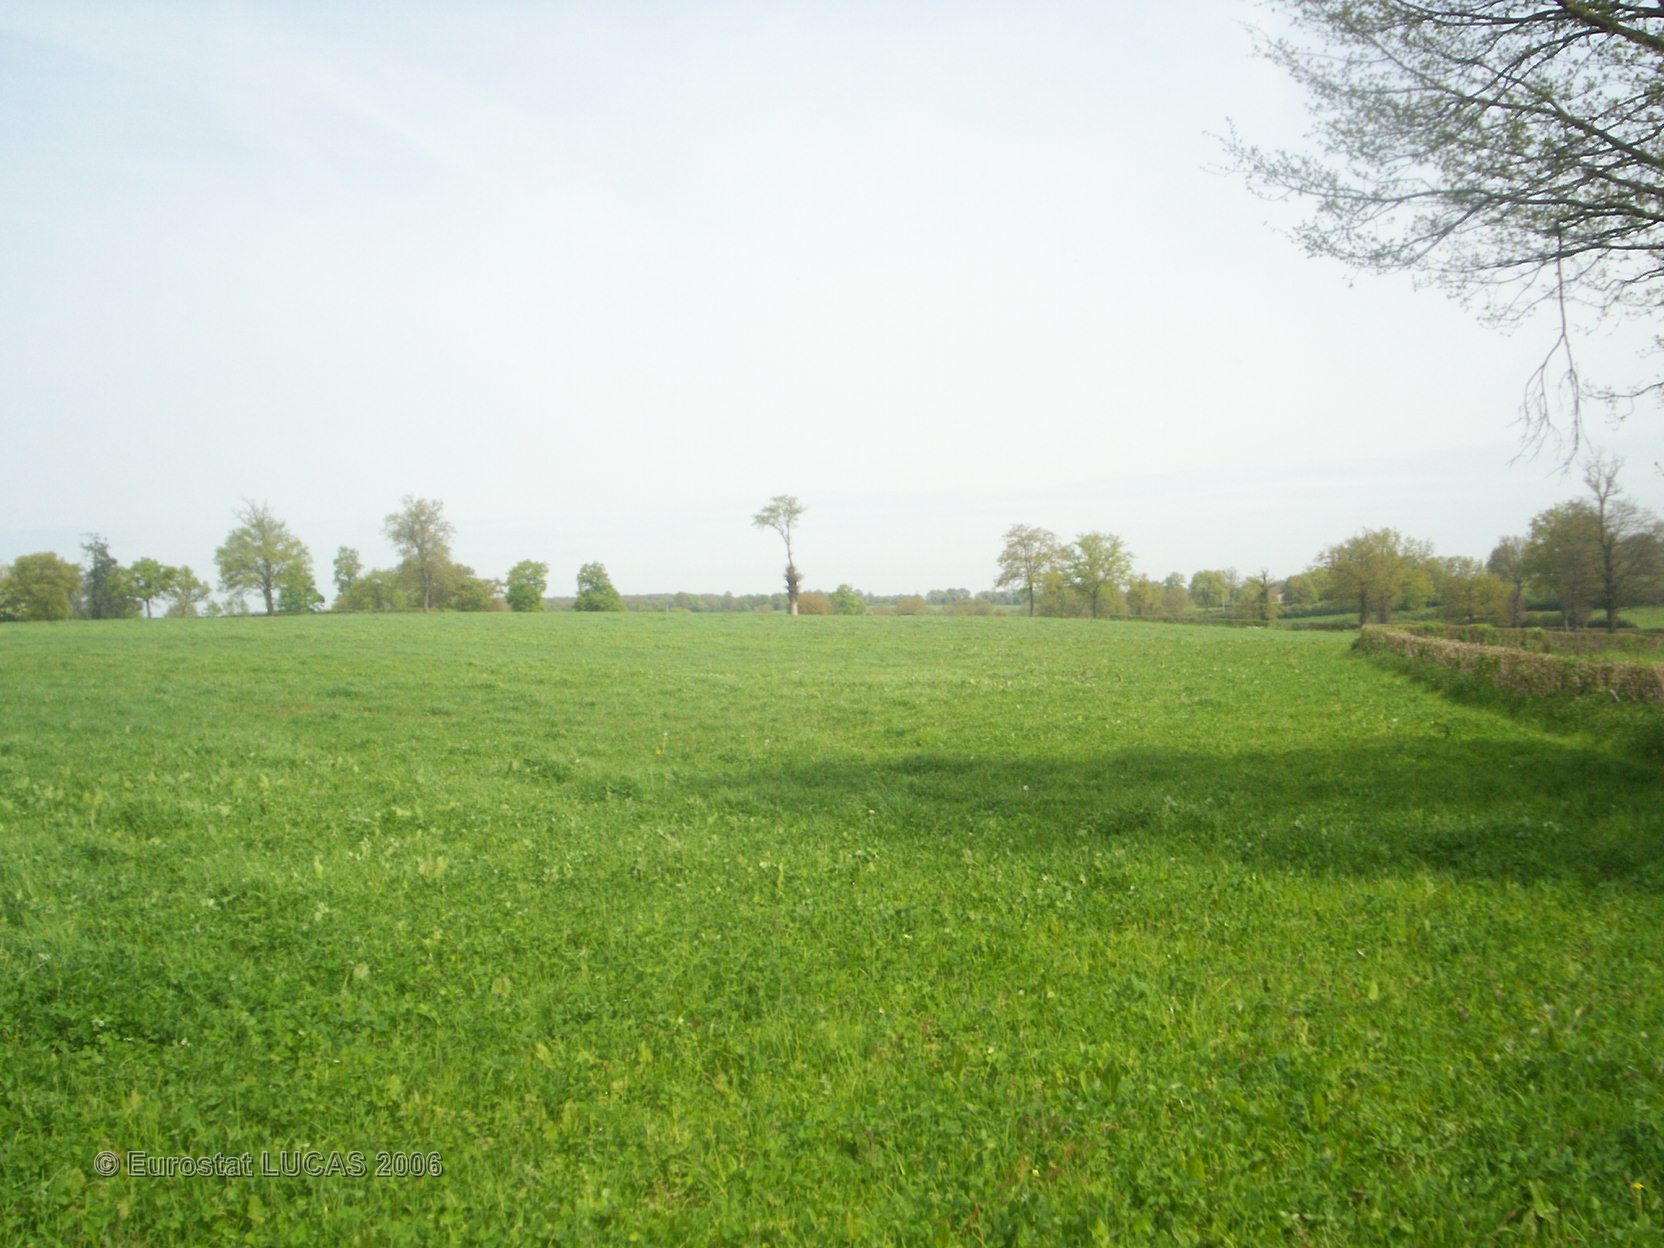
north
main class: Grassland
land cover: Grassland without tree/shrub cover
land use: Agriculture (excluding fallow land and kitchen gardens)
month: May
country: FR
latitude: 46.5635
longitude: 3.1225
